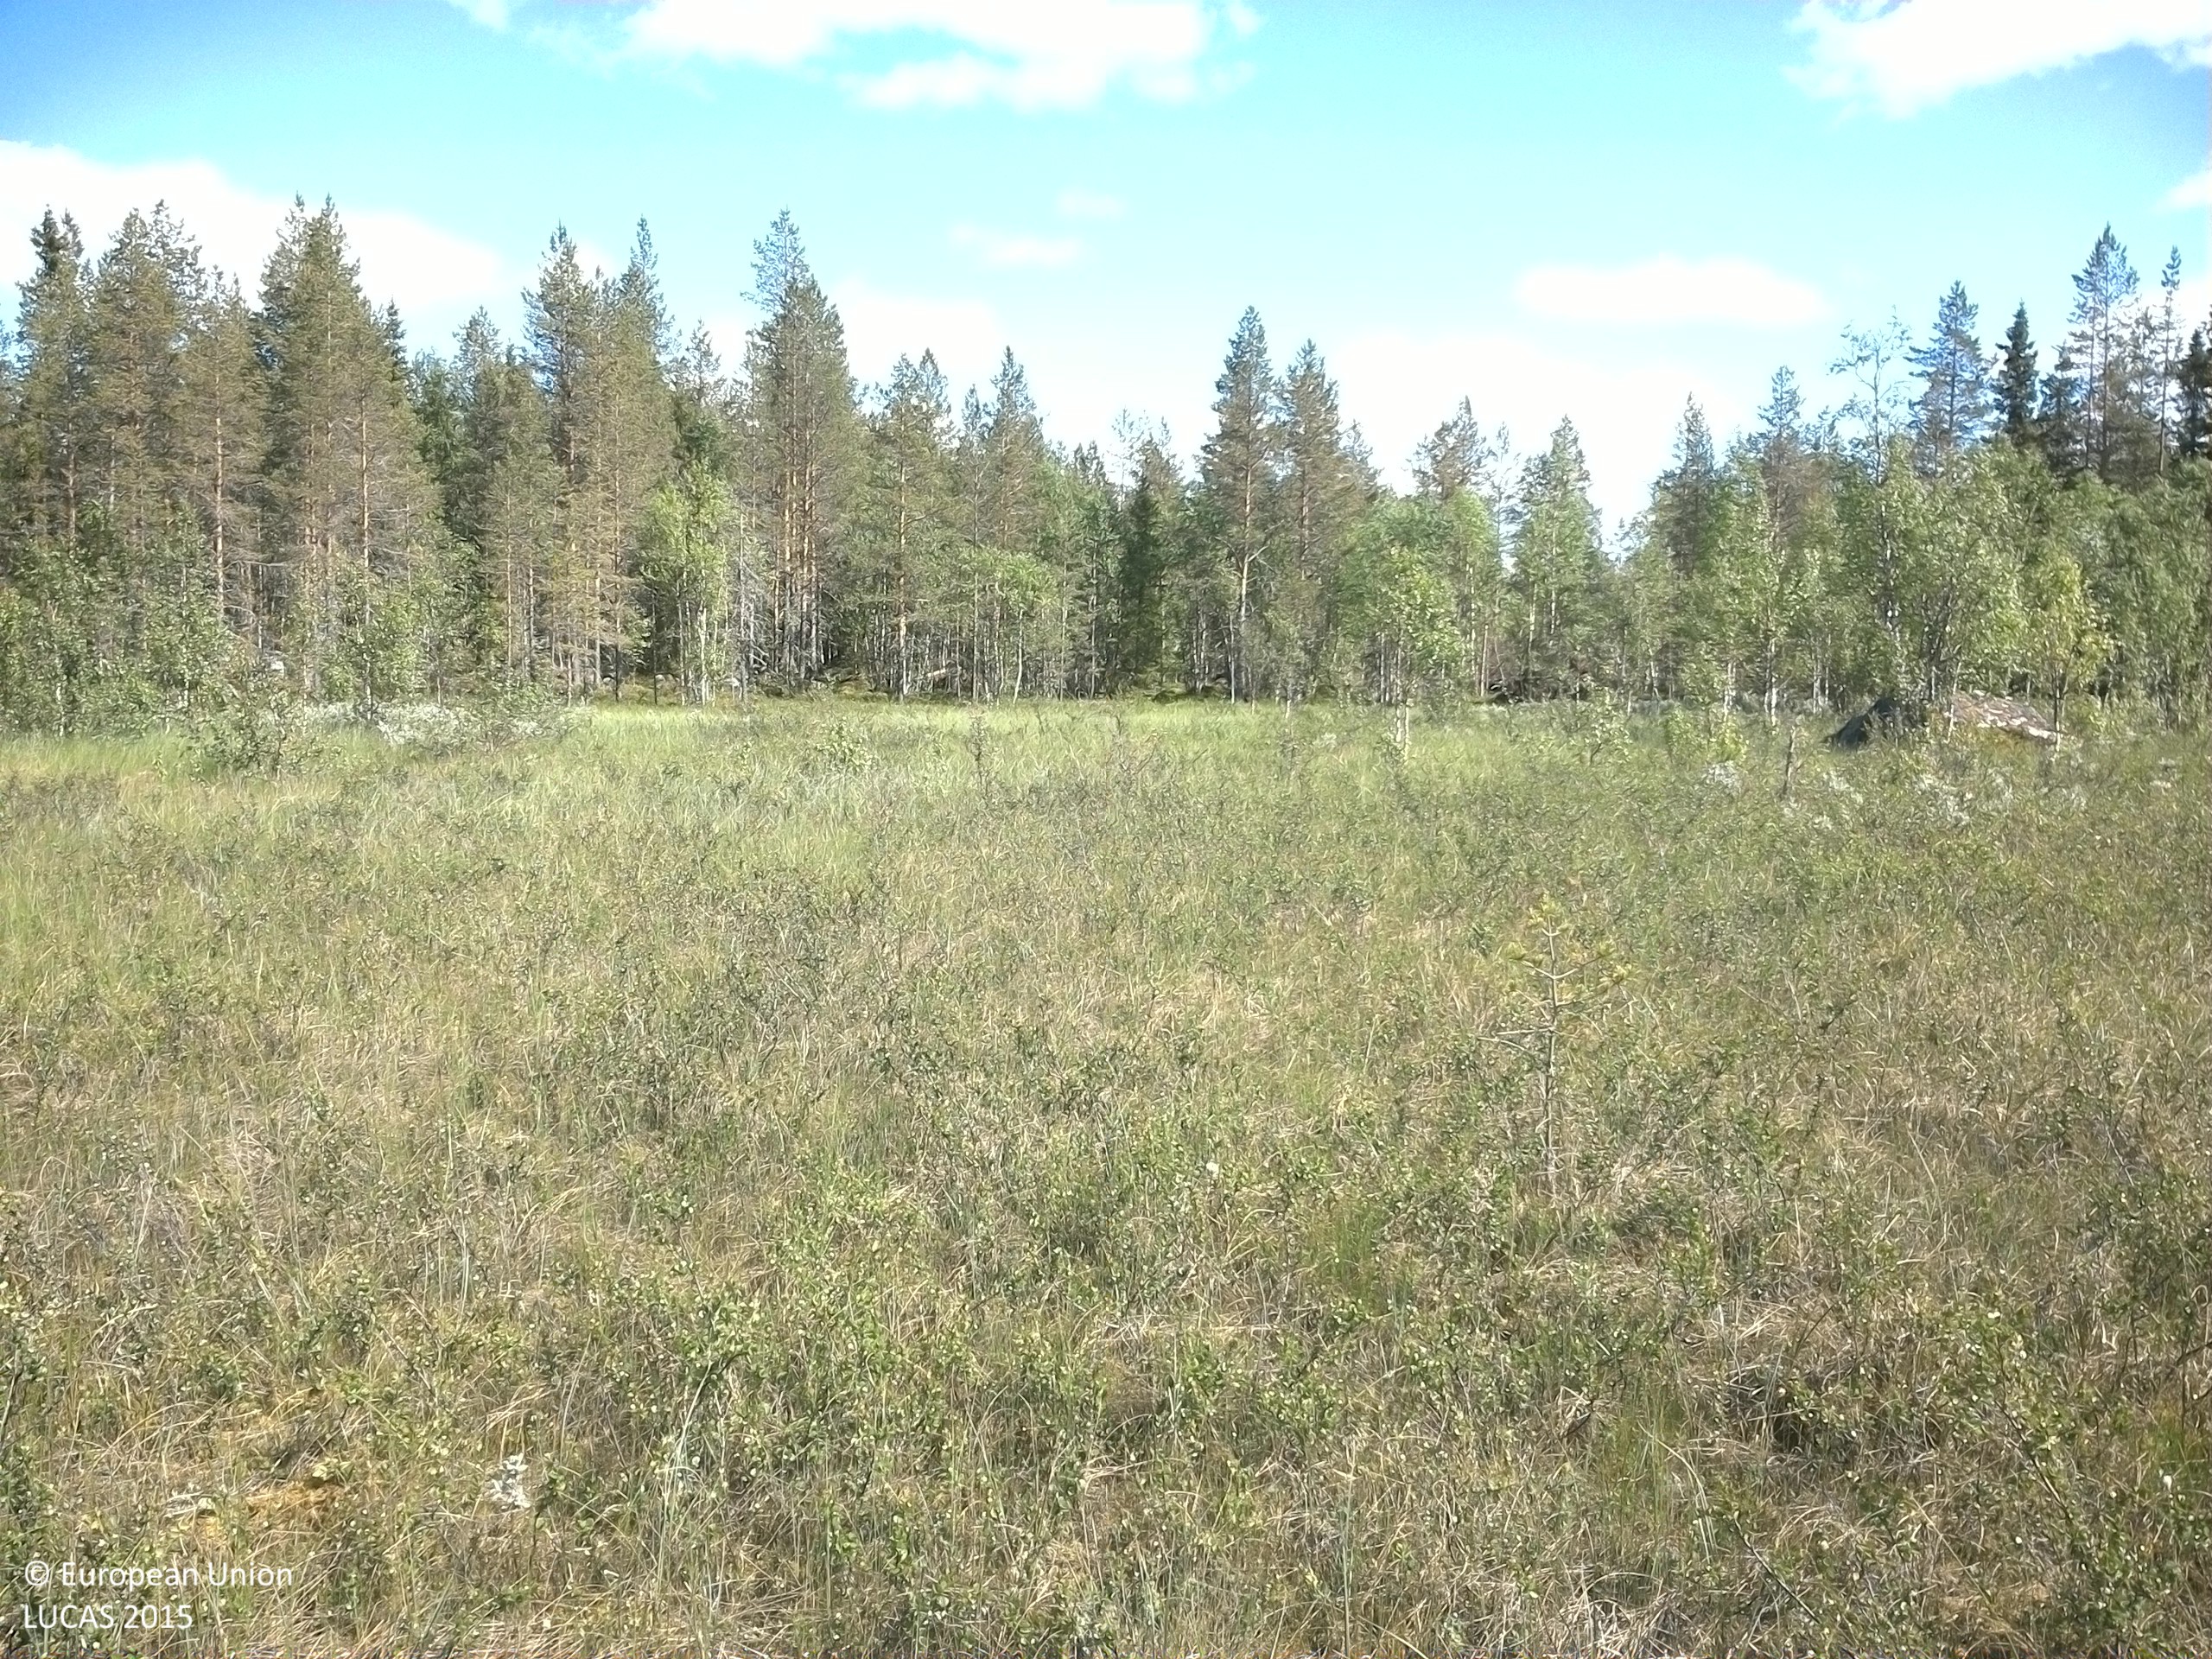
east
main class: Grassland
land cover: Grassland with sparse tree/shrub cover
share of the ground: 50 - 75 %
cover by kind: herbaceous plants 60 %, lichens and mosses 30 %, broadleaved forest trees 5 %, shrubs 5 %
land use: Semi-natural and natural areas not in use
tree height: < 5 m
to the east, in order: Grassland with sparse tree/shrub cover; Shrubland with sparse tree cover; Inland marshes; Pine dominated mixed woodland; Rocks and stones; Pine dominated mixed woodland; Ditches and canals; Pine dominated mixed woodland; Grass margins; Paved roads, cycling and walking lanes; Grass margins; Broadleaved woodland; Pine dominated mixed woodland; Spruce dominated mixed woodland
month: July
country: SE
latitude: 64.3098
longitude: 16.7295
